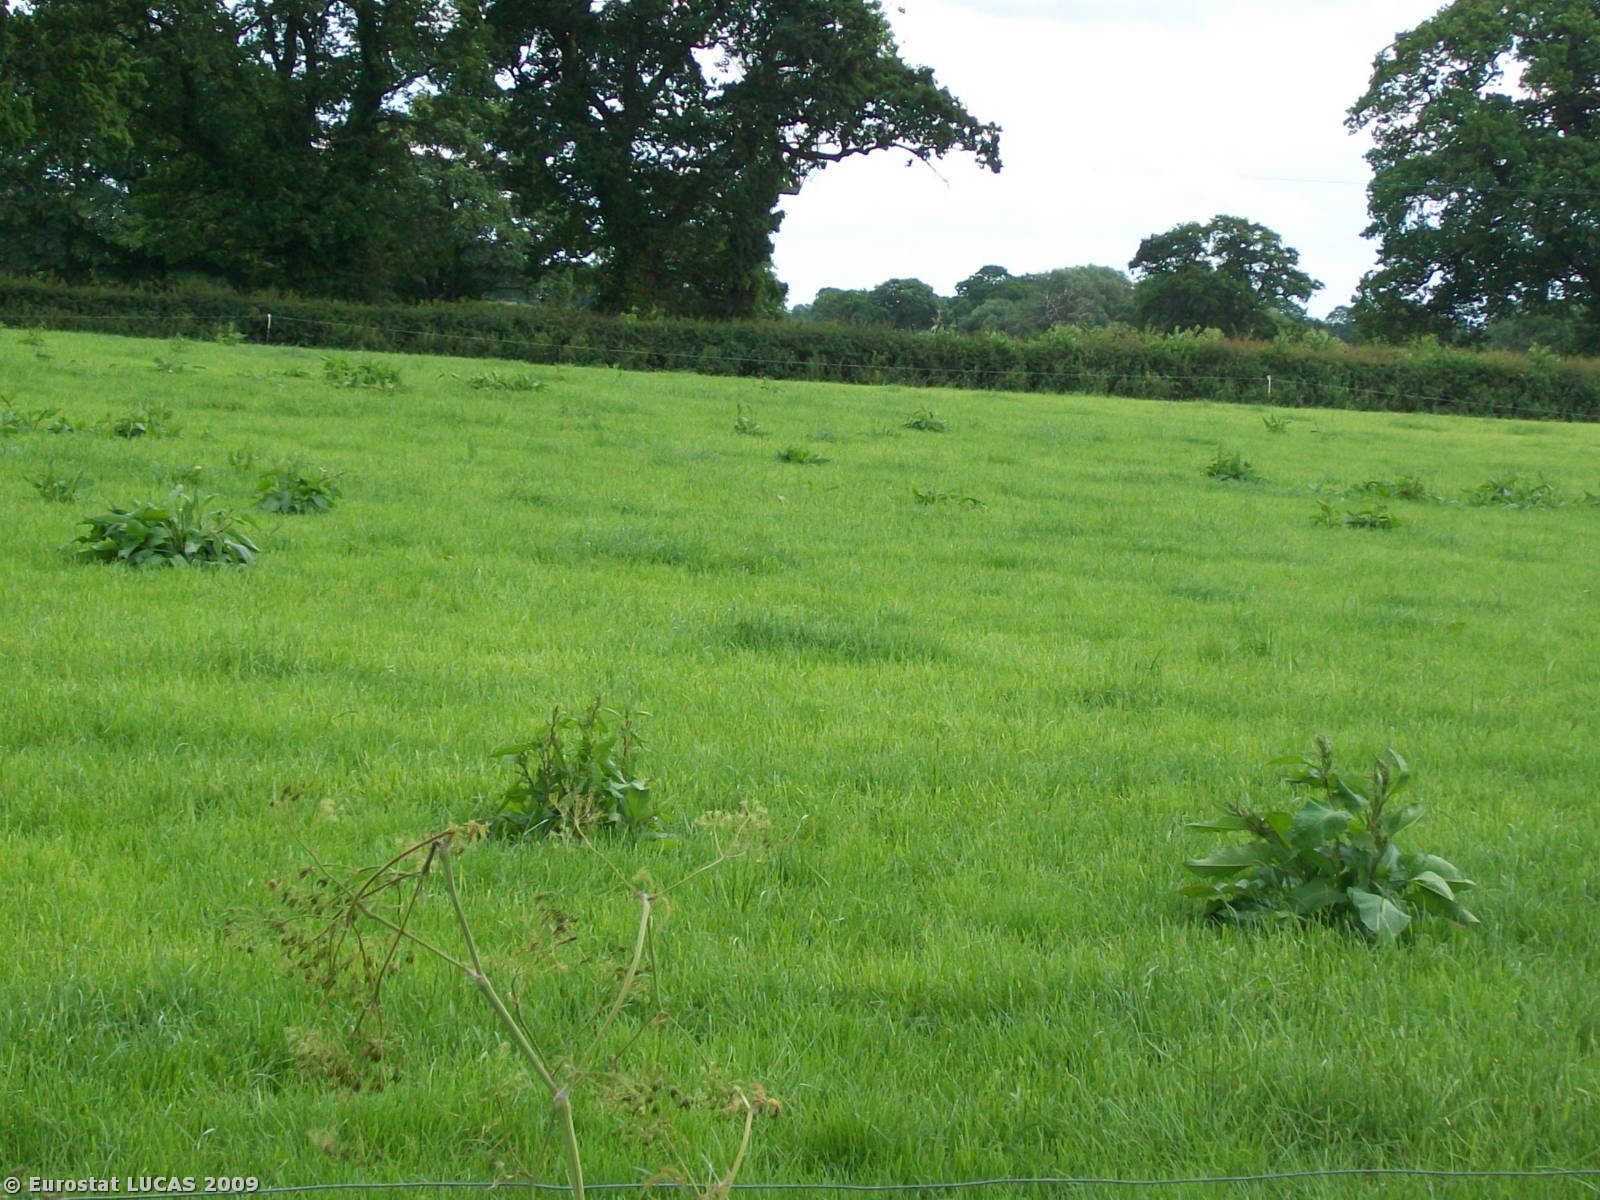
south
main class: Grassland
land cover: Grassland without tree/shrub cover
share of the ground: > 75 %
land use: Agriculture (excluding fallow land and kitchen gardens)
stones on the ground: < 10 %
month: June
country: GB
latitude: 52.9395
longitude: -2.6116
